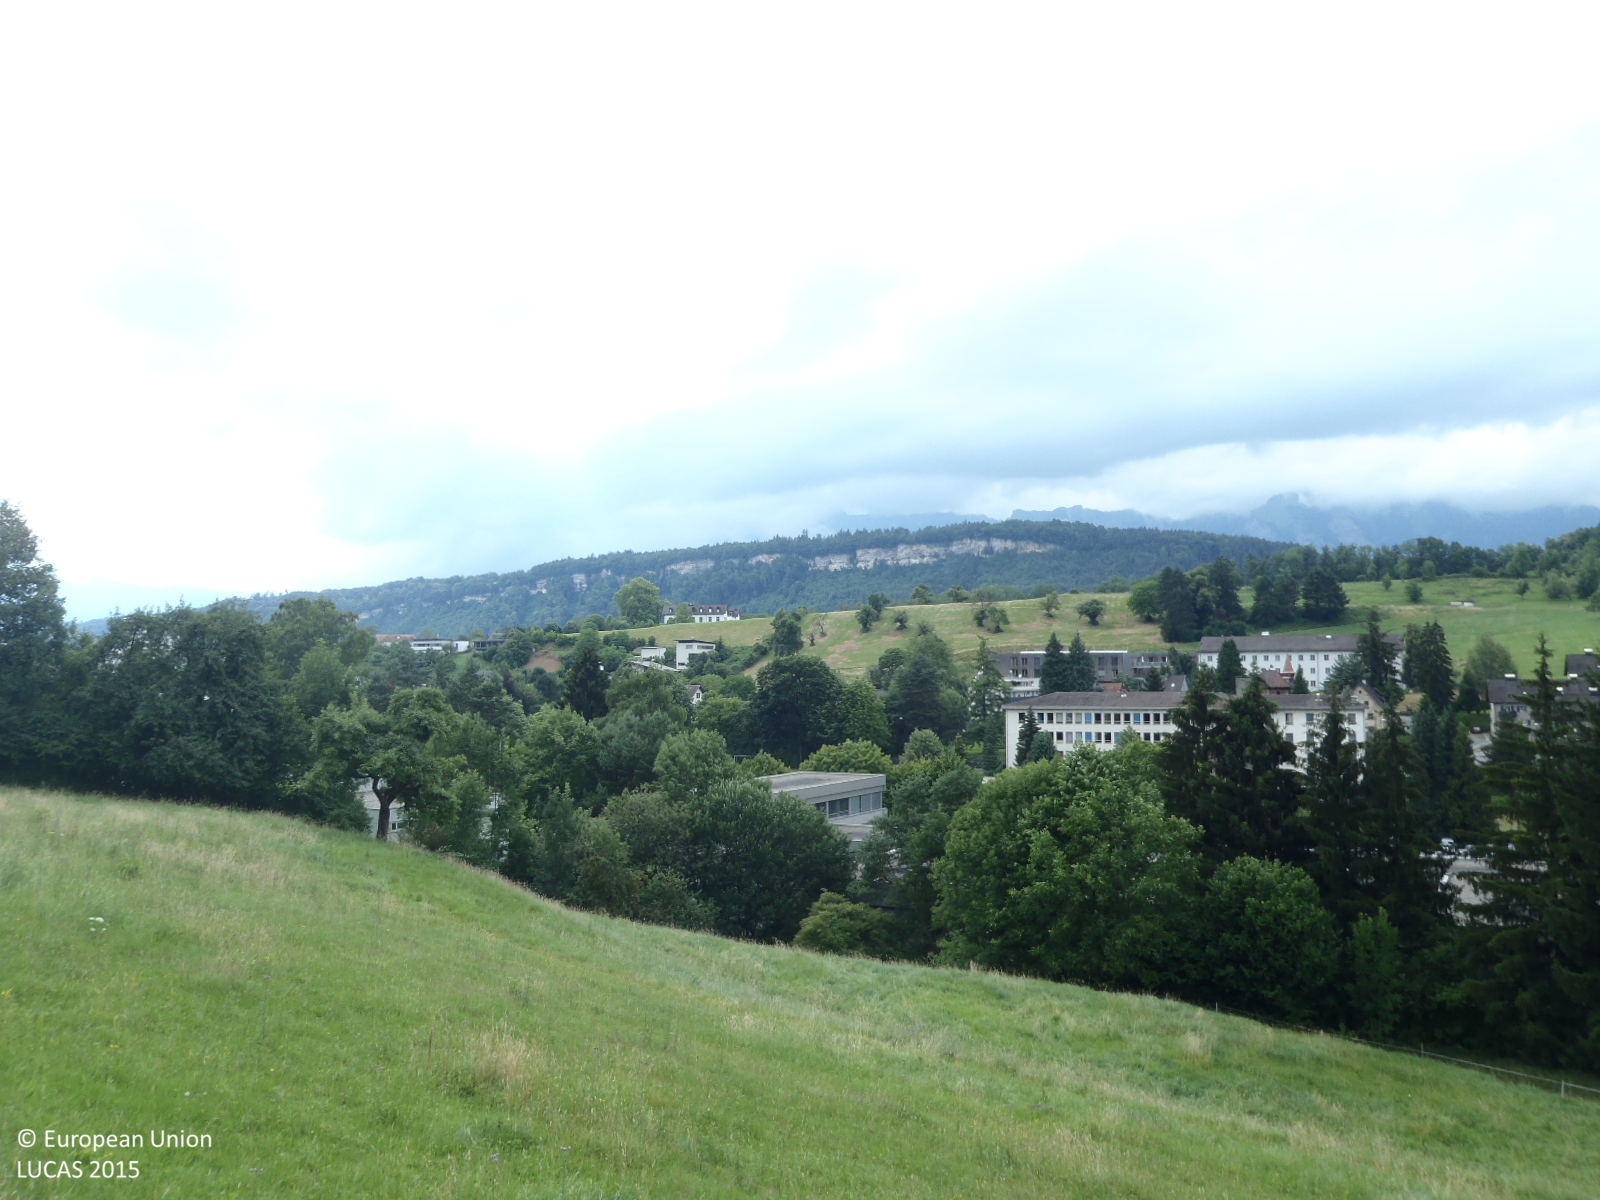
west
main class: Grassland
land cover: Grassland without tree/shrub cover
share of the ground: > 75 %
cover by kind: herbaceous plants 100 %
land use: Agriculture (excluding fallow land and kitchen gardens)
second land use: Amenities, museums, leisure
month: July
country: AT
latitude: 47.2328
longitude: 9.5909
